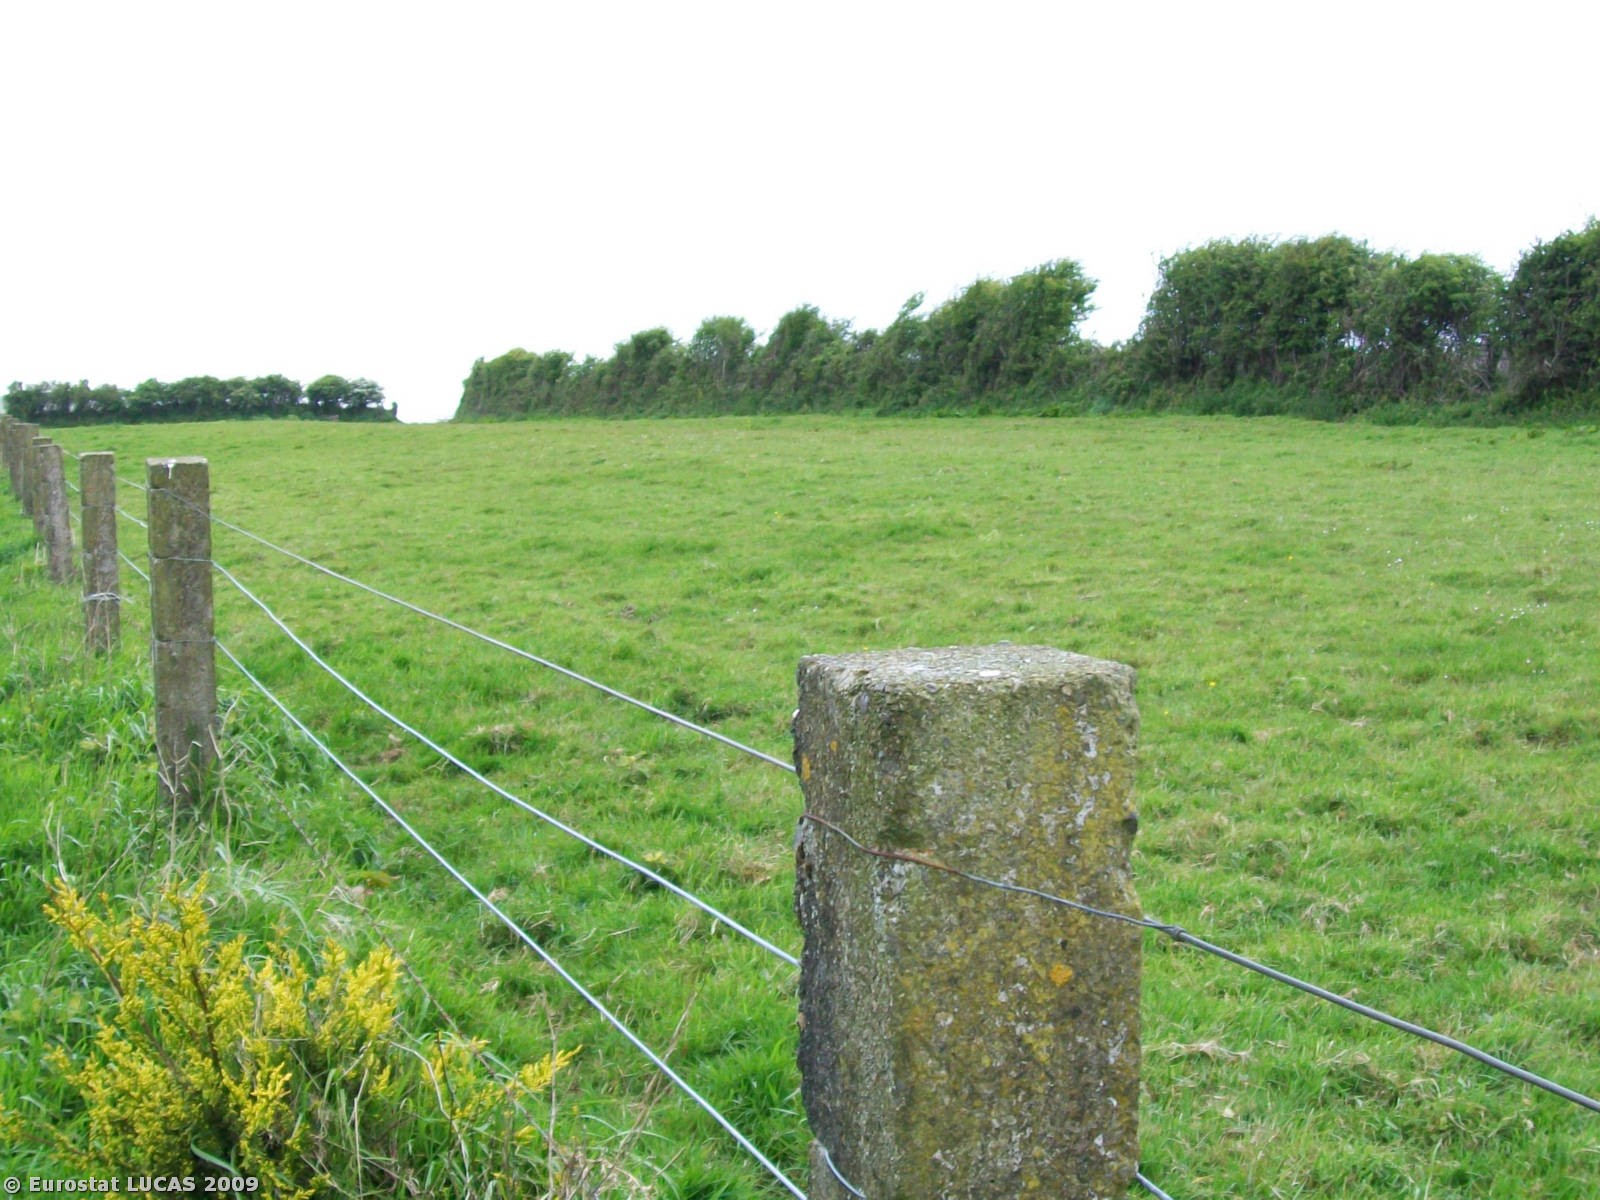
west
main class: Cropland
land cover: Common wheat
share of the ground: > 75 %
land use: Agriculture (excluding fallow land and kitchen gardens)
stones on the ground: < 10 %
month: May
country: IE
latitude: 51.7110
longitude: -8.6522
